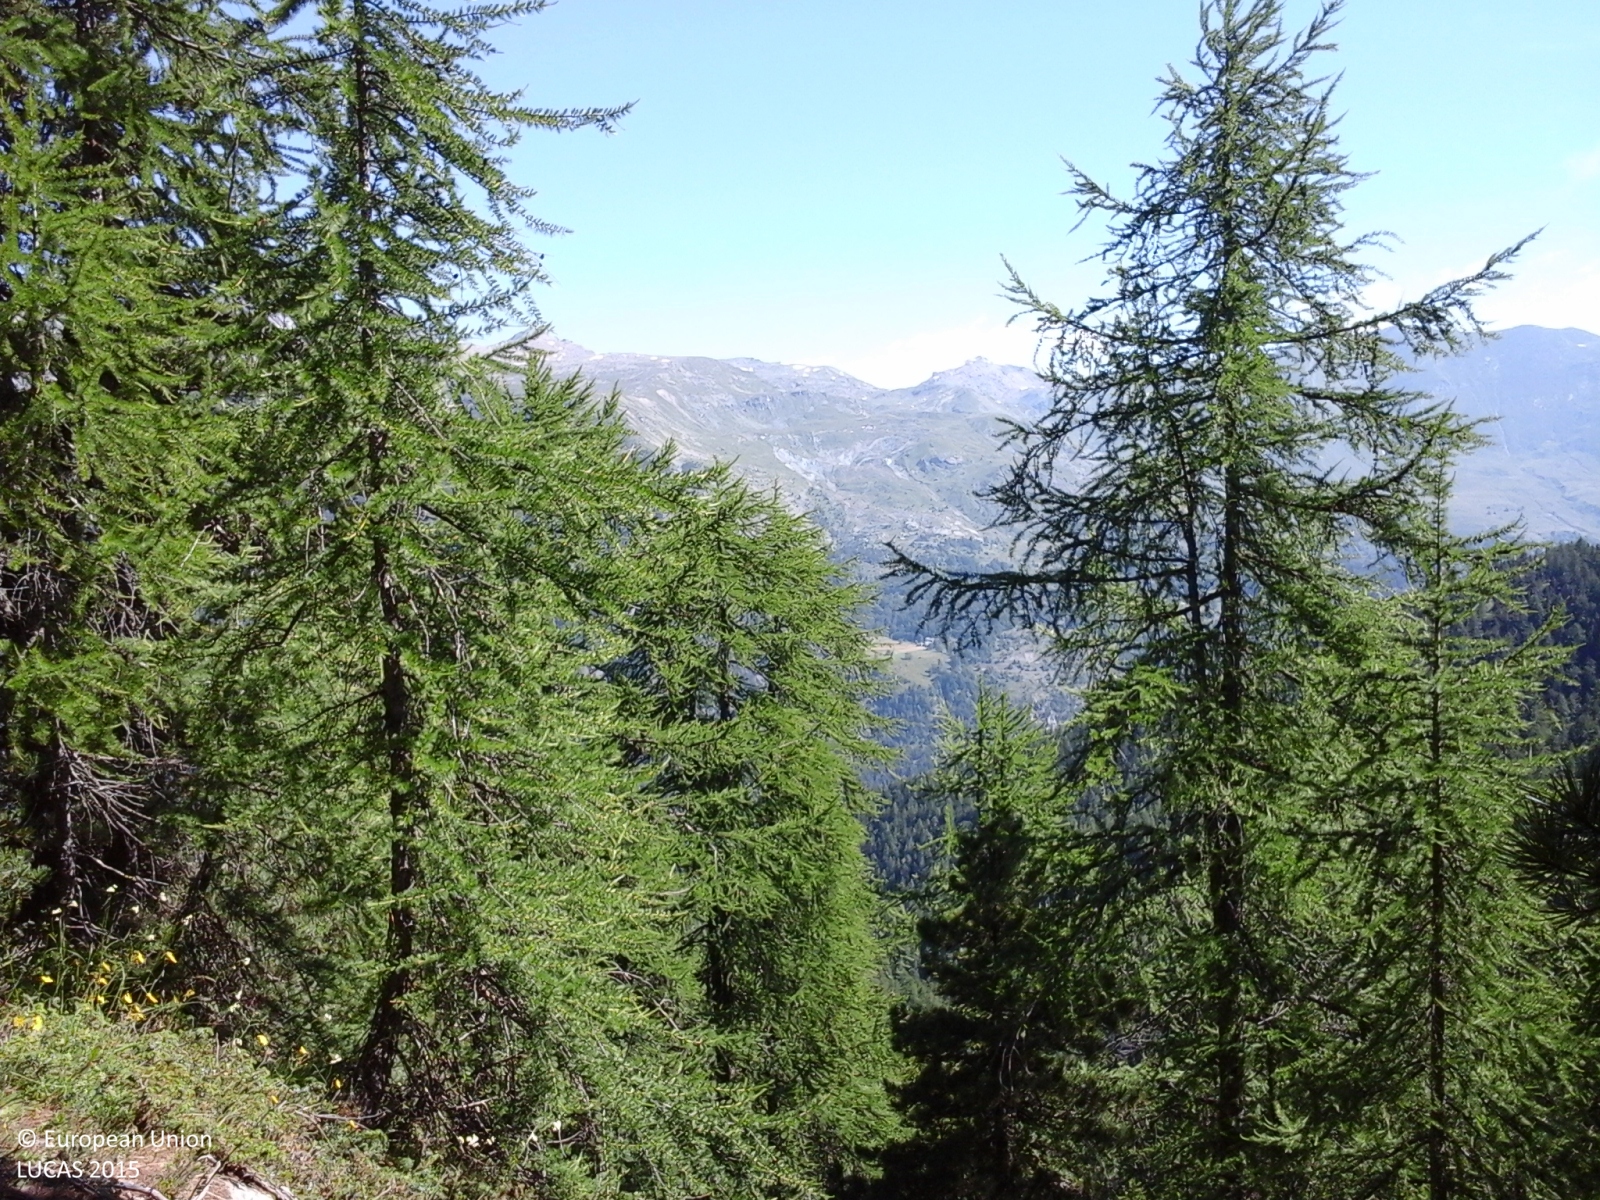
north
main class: Woodland
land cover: Pine dominated coniferous woodland
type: alpine coniferous forest
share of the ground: > 75 %
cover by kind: coniferous forest trees 100 %
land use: Semi-natural and natural areas not in use
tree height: > 5 m
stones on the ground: < 10 %
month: June
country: IT
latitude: 44.5633
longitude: 7.1223
